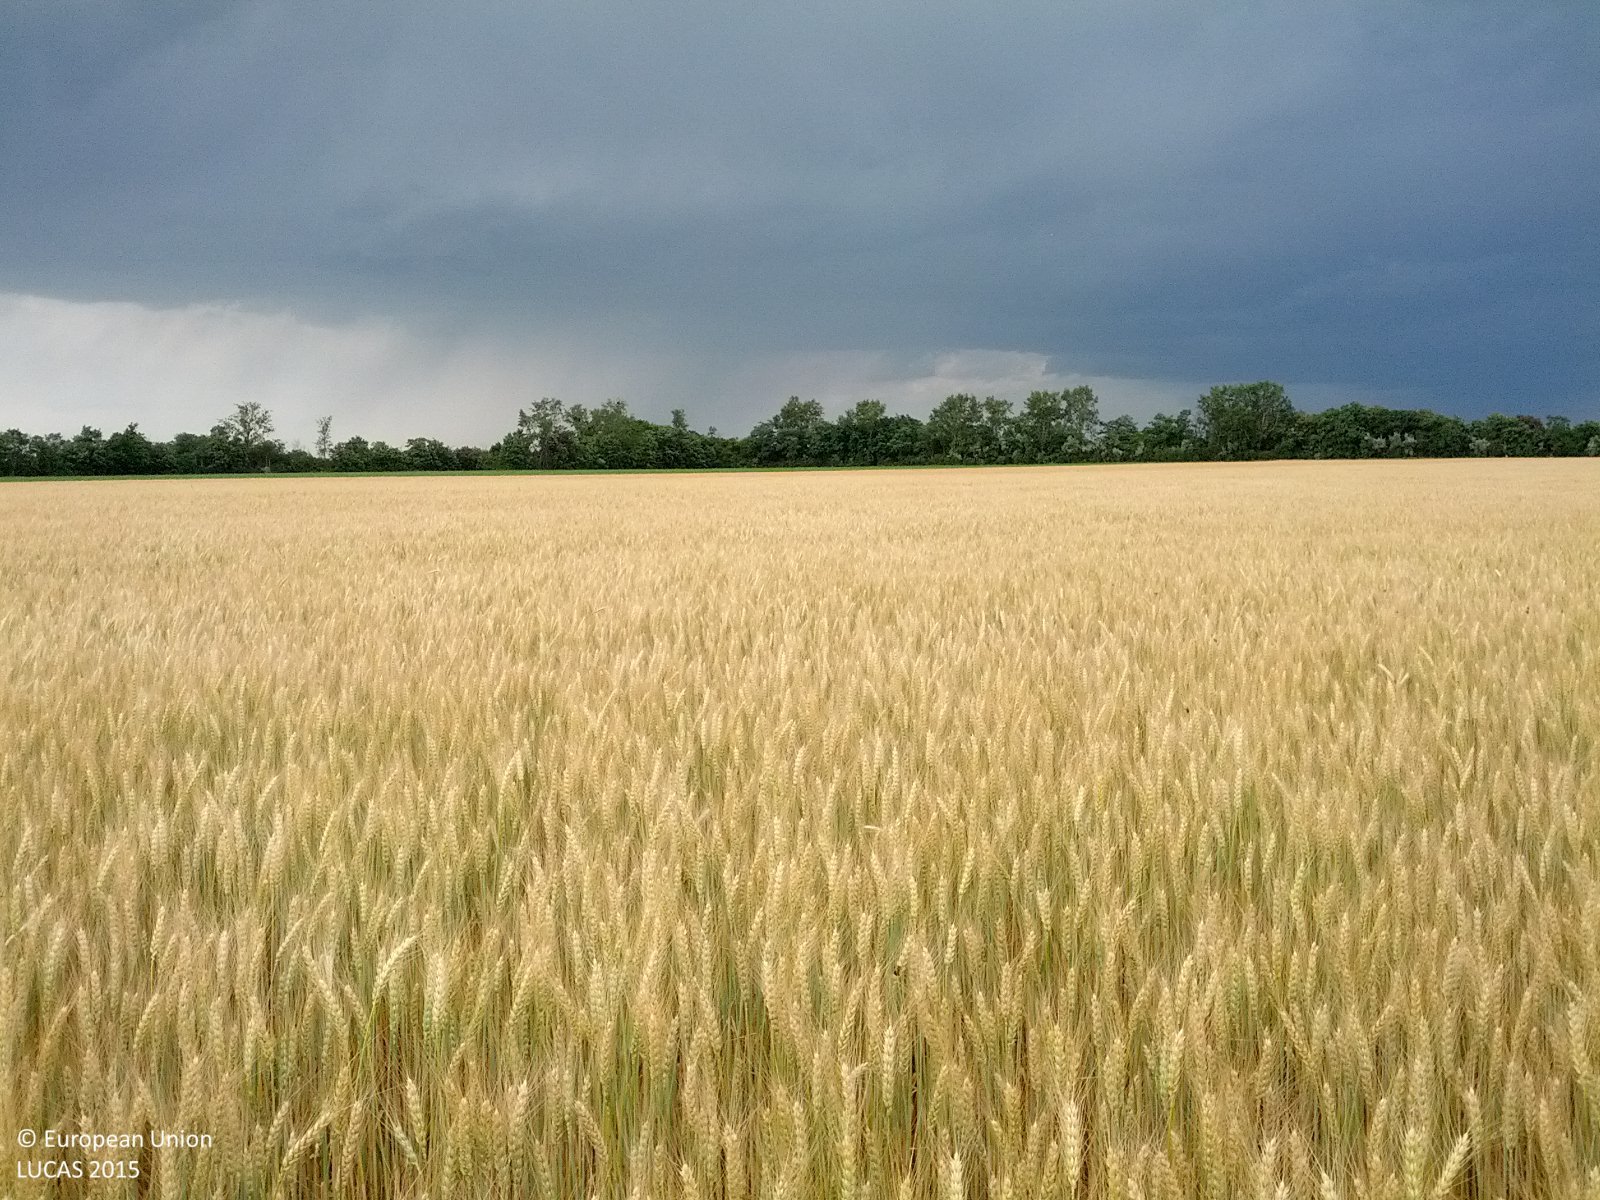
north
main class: Cropland
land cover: Common wheat
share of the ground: > 75 %
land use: Agriculture (excluding fallow land and kitchen gardens)
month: June
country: AT
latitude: 48.2673
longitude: 16.7832
